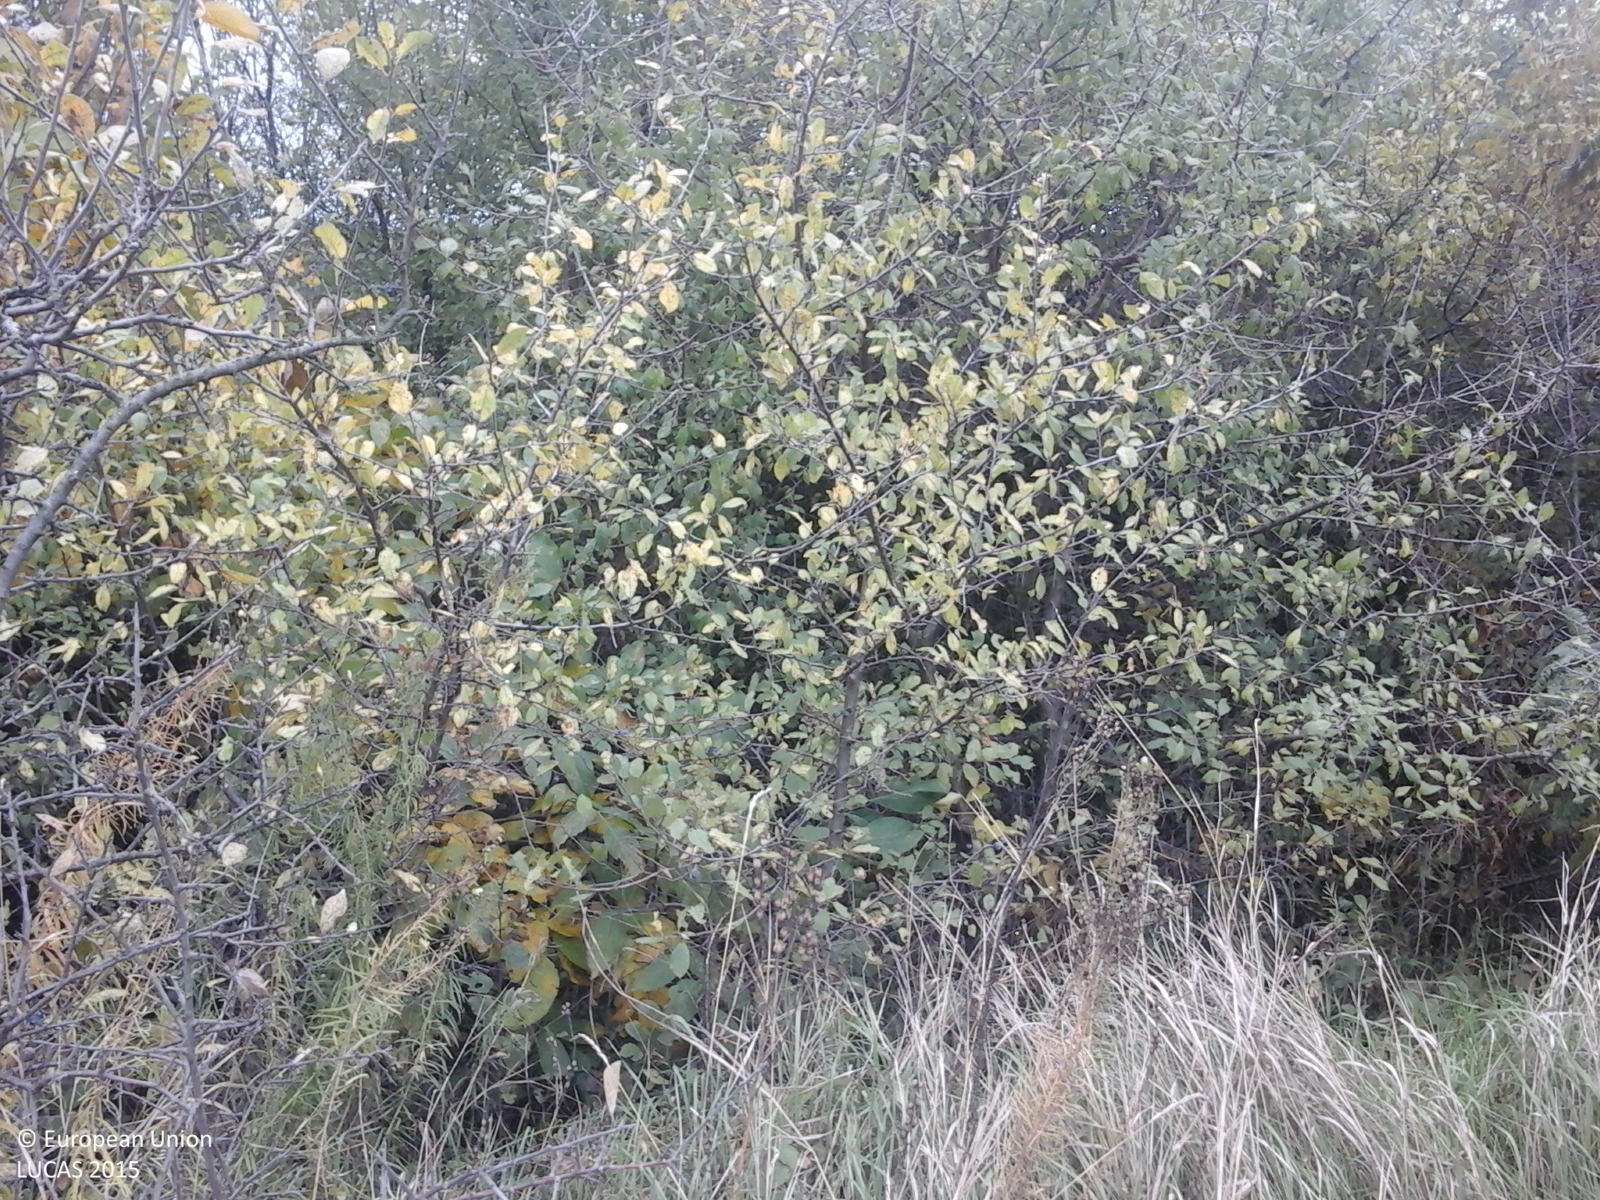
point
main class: Cropland
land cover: Common wheat
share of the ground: < 10 %
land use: Agriculture (excluding fallow land and kitchen gardens)
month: October
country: RO
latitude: 44.7600
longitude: 26.0632
